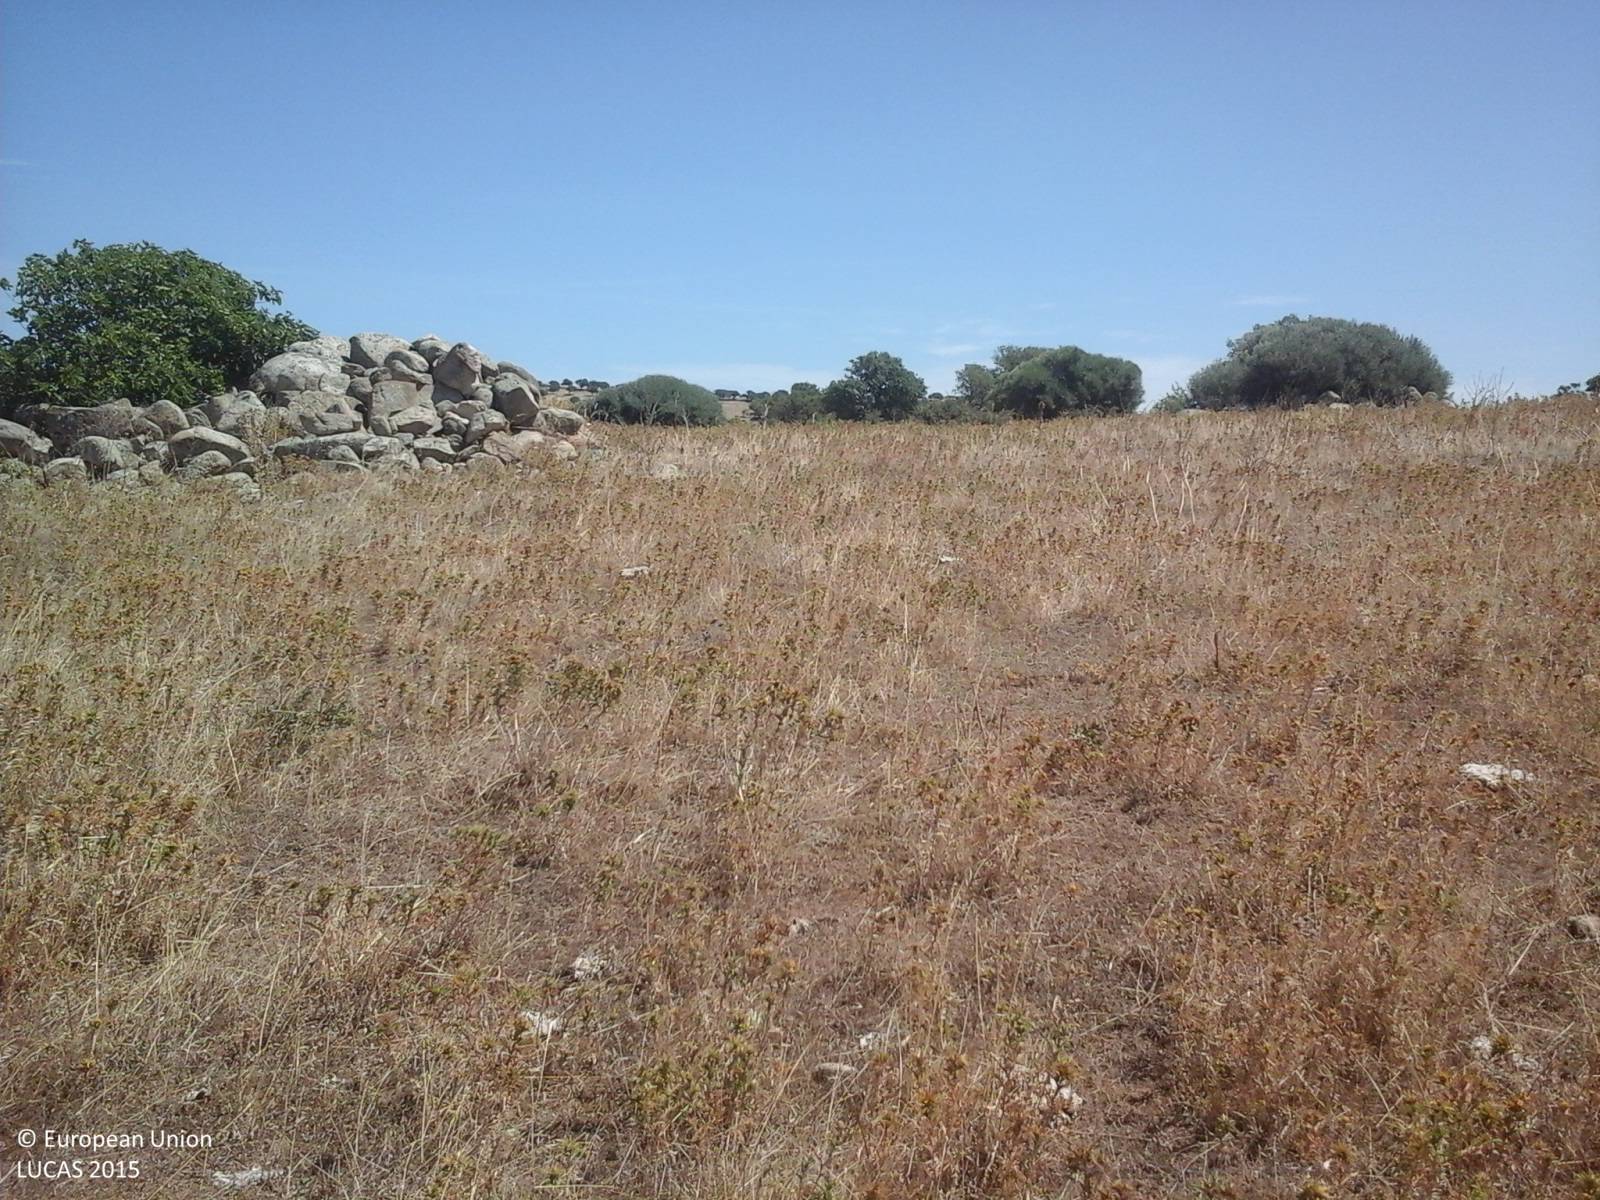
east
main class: Grassland
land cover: Grassland with sparse tree/shrub cover
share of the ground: > 75 %
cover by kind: herbaceous plants 90 %, broadleaved forest trees 5 %, shrubs 5 %
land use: Agriculture (excluding fallow land and kitchen gardens)
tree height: > 5 m
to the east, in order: Grassland with sparse tree/shrub cover; Rocks and stones; Broadleaved woodland; Rocks and stones; Broadleaved woodland; Grassland with sparse tree/shrub cover; Fences; Abandoned hedges; Grassland with sparse tree/shrub cover; Fences; Dry stone walls; Grassland with sparse tree/shrub cover; Grassland without tree/shrub cover
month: July
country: IT
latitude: 40.7709
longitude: 9.2100
